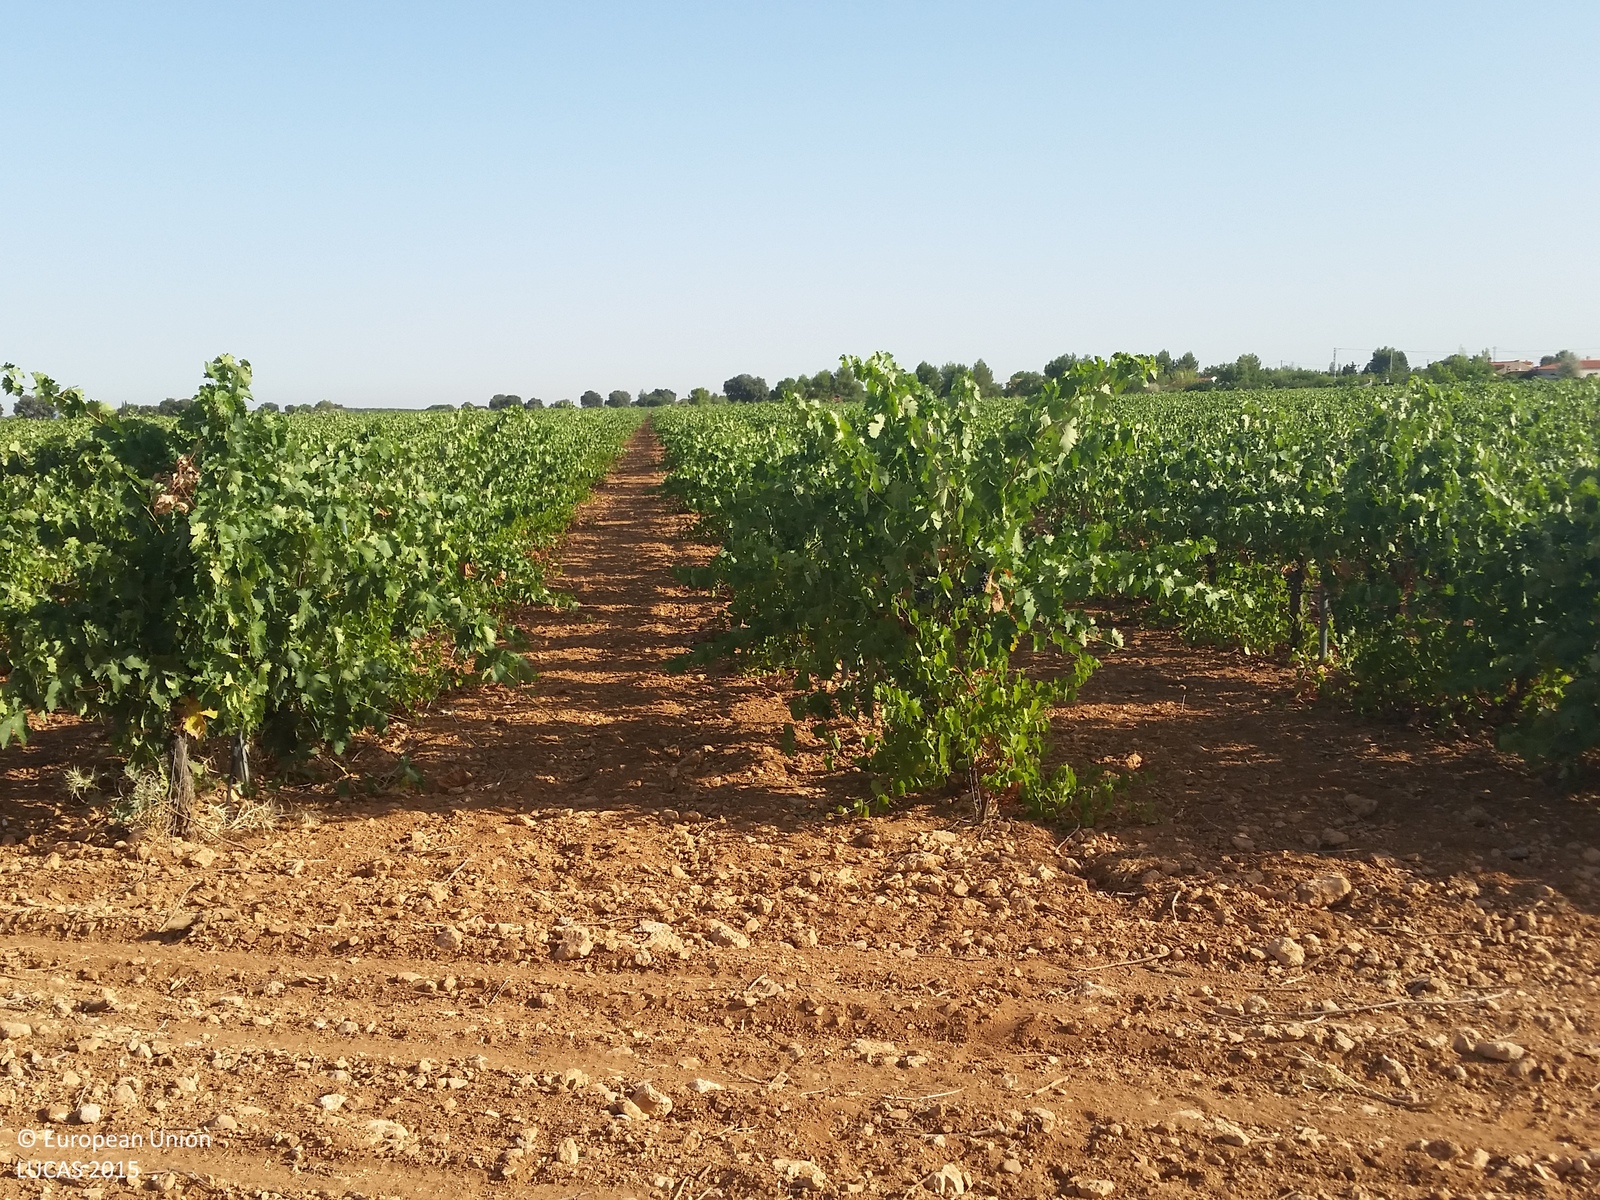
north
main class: Cropland
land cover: Vineyards
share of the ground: 50 - 75 %
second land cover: Other bare soil
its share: > 75 %
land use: Agriculture (excluding fallow land and kitchen gardens)
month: July
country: ES
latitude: 39.2971
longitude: -2.6615
